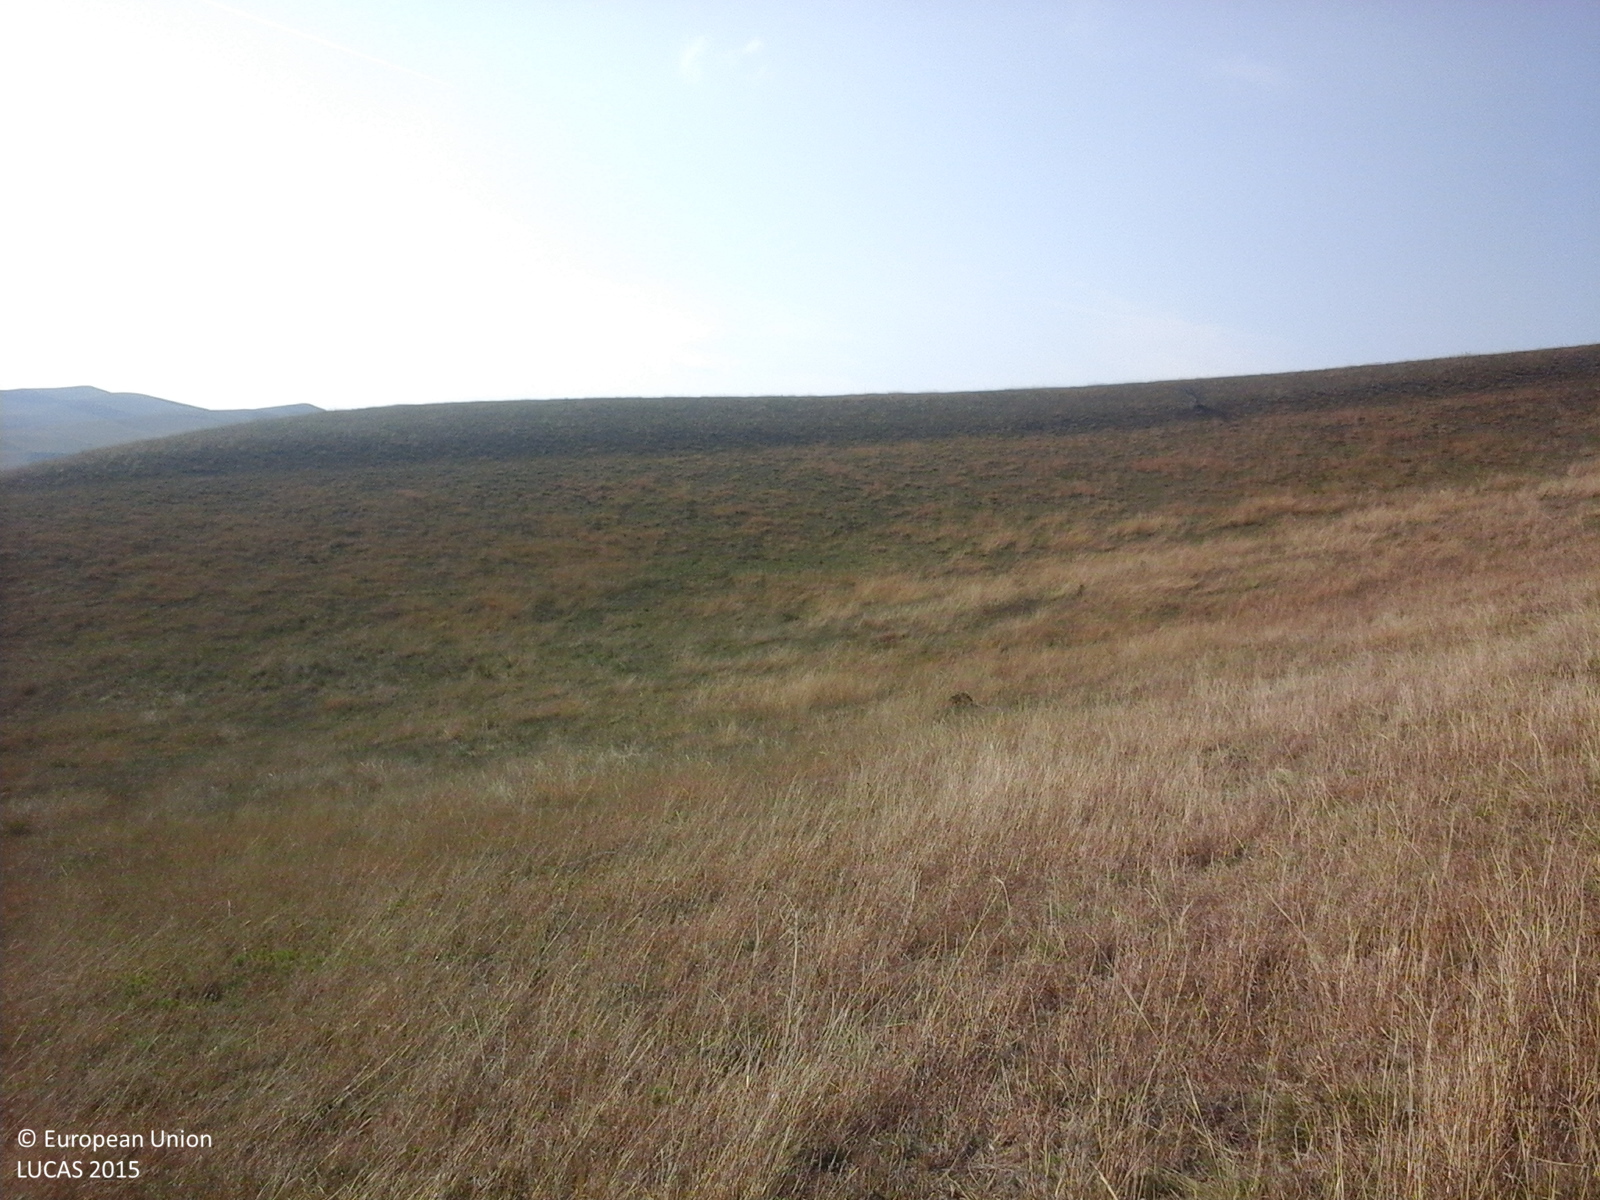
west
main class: Grassland
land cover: Grassland without tree/shrub cover
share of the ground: > 75 %
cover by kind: herbaceous plants 100 %
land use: Agriculture (excluding fallow land and kitchen gardens)
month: October
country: RO
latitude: 46.2935
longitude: 23.9250
